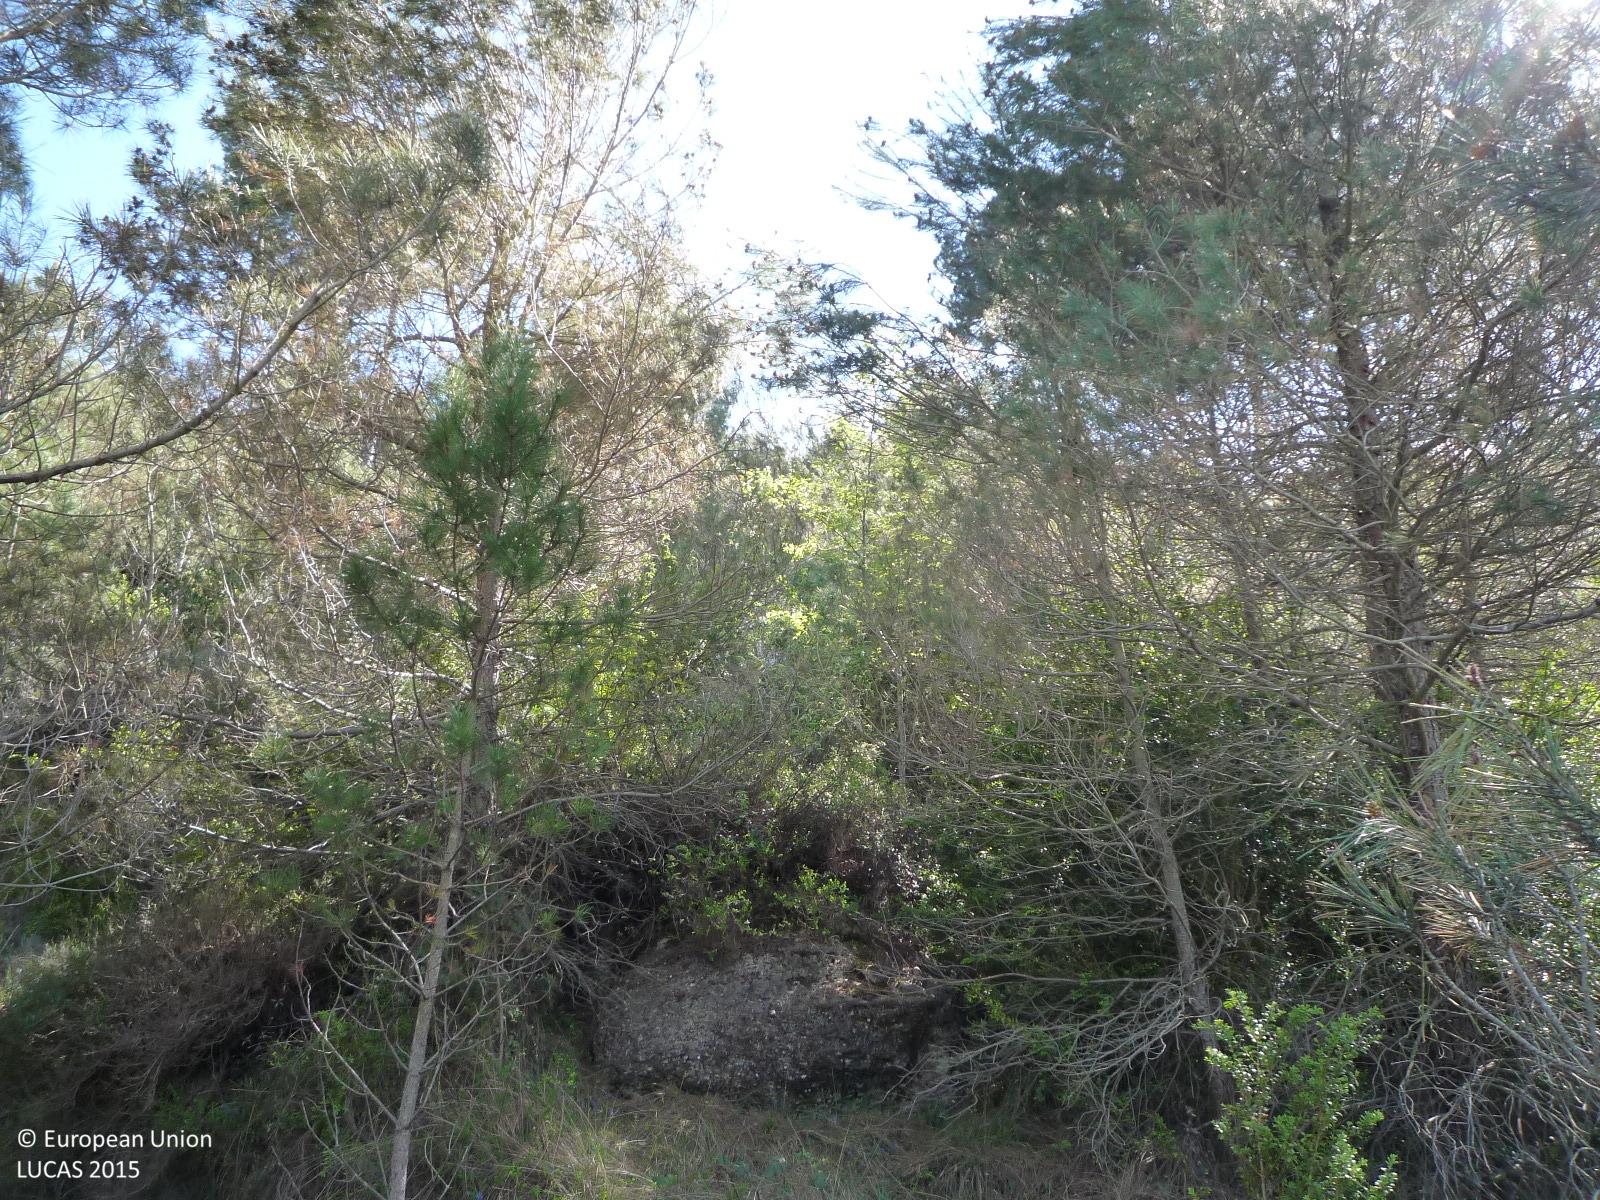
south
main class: Woodland
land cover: Pine dominated mixed woodland
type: coniferous forest of the mediterranean region
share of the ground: > 75 %
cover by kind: coniferous forest trees 75 %, broadleaved forest trees 25 %
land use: Forestry
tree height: < 5 m
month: April
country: ES
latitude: 41.6709
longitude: 1.6192
